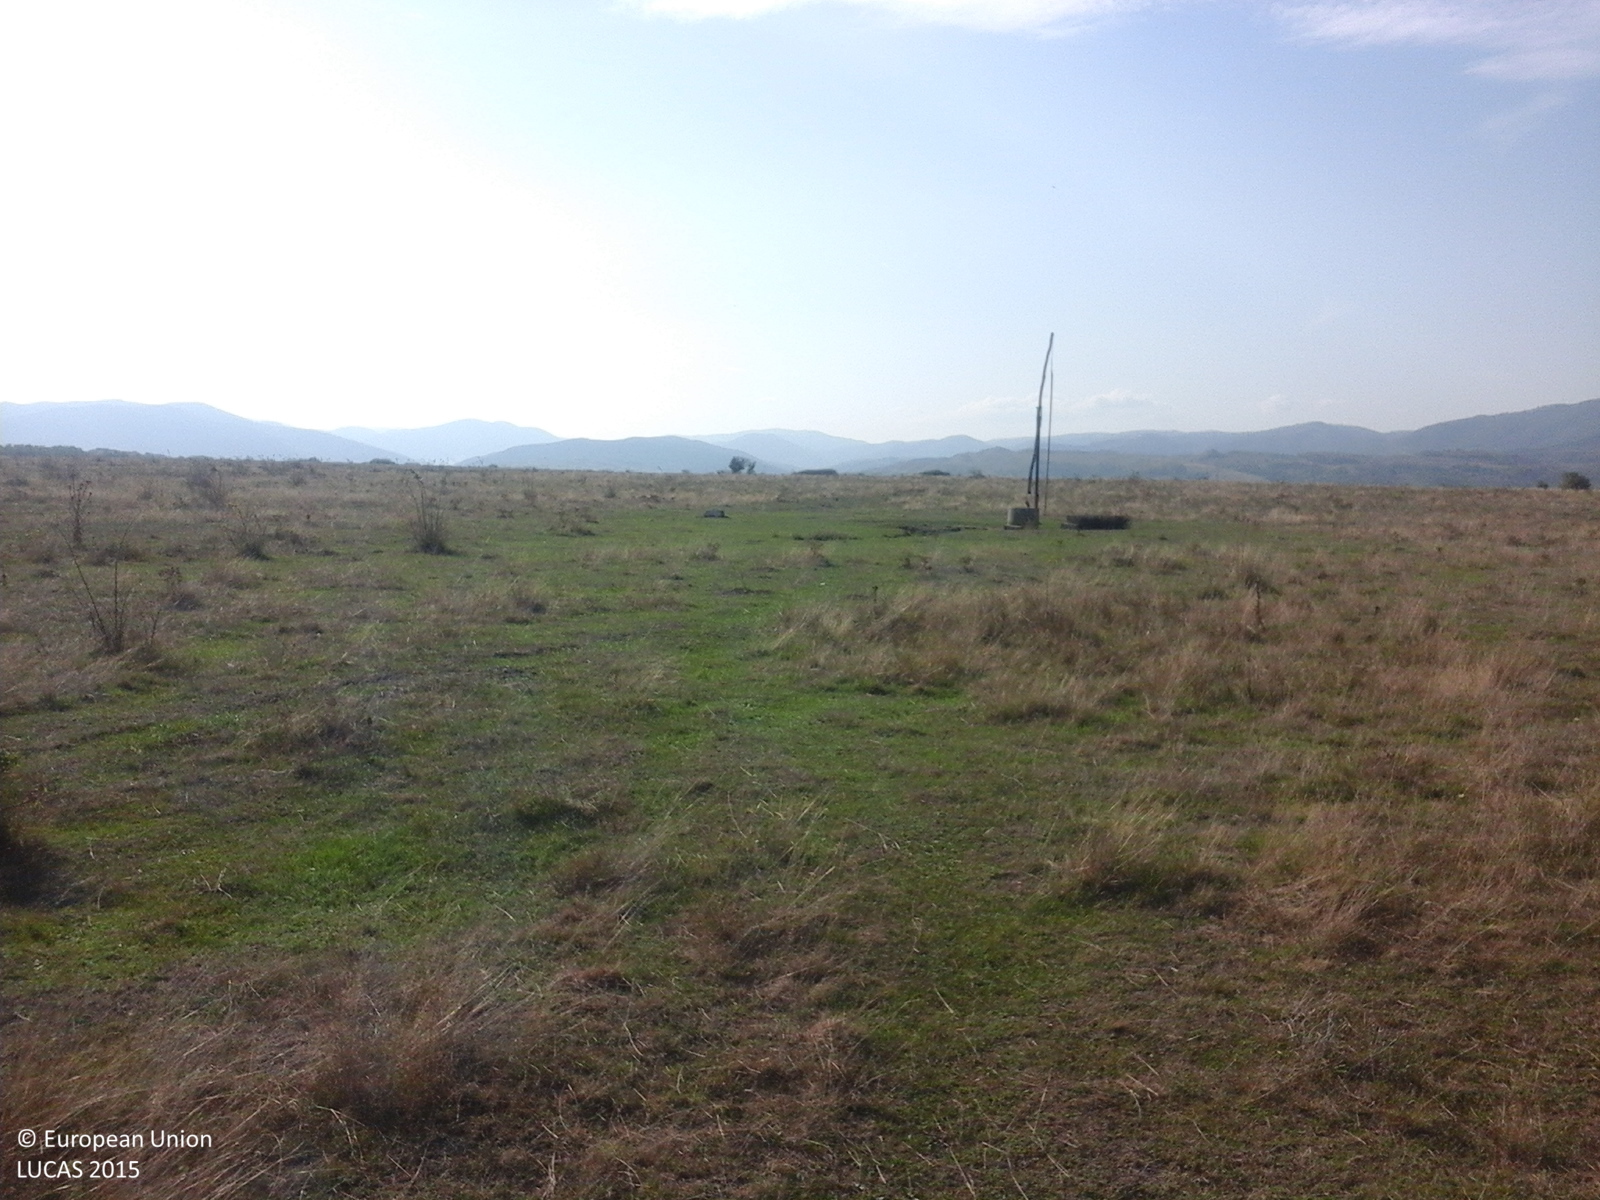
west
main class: Grassland
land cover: Grassland without tree/shrub cover
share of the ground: > 75 %
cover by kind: herbaceous plants 100 %
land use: Agriculture (excluding fallow land and kitchen gardens)
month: September
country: RO
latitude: 45.5867
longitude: 22.8818
